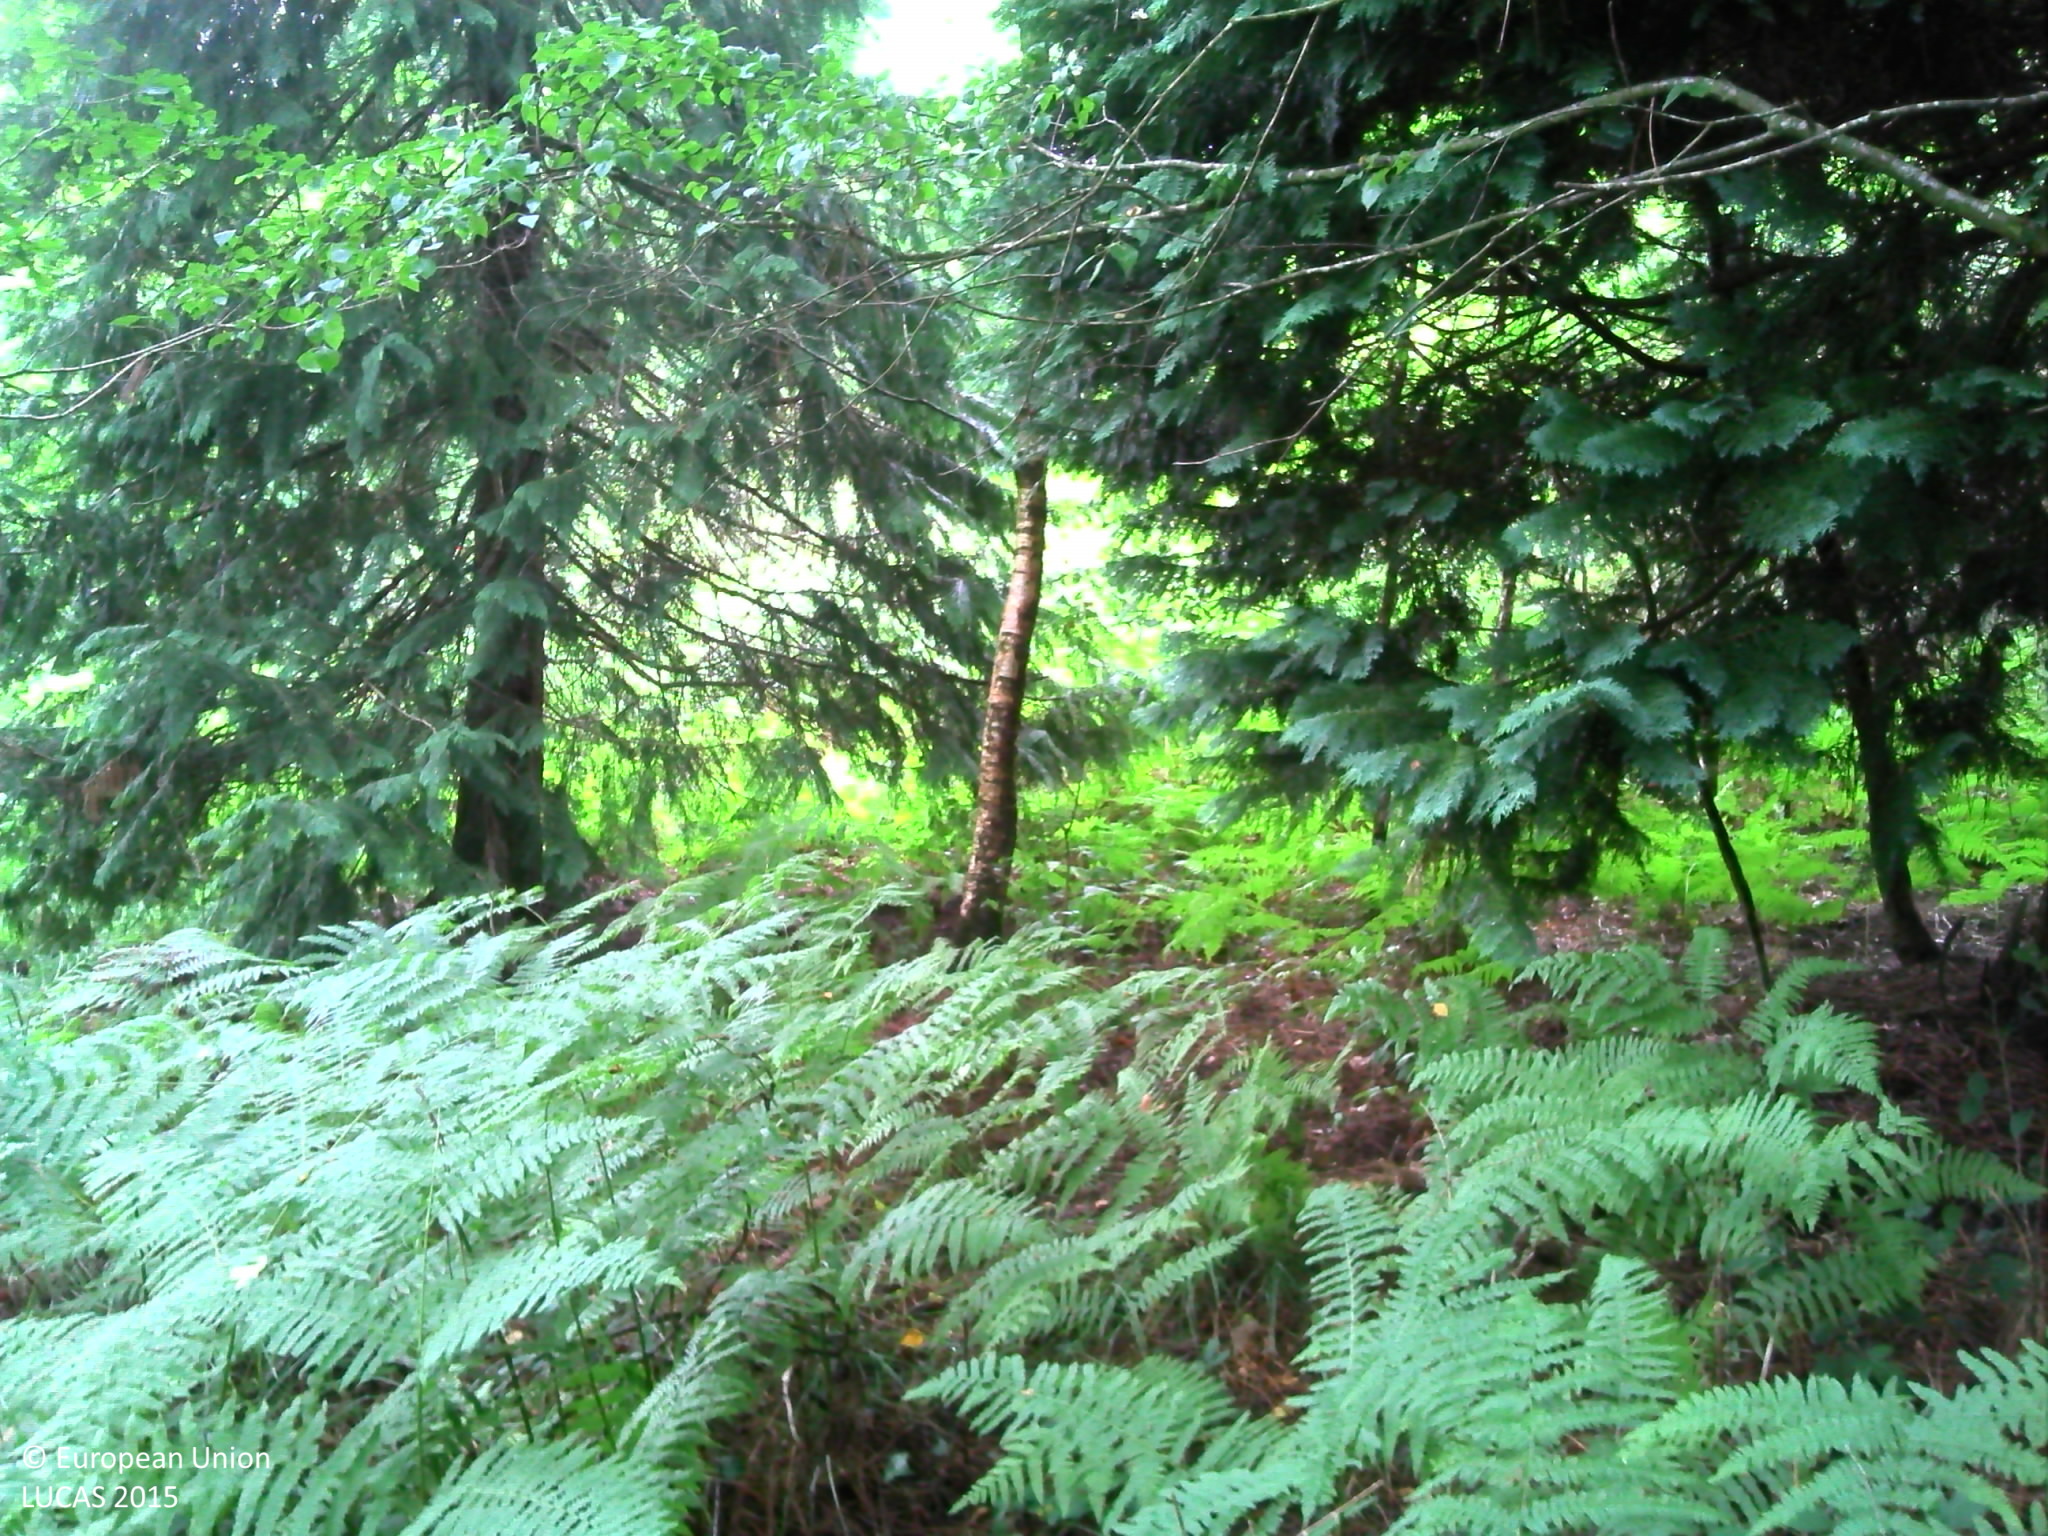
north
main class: Woodland
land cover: Other mixed woodland
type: exotic forest
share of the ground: > 75 %
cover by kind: broadleaved forest trees 40 %, coniferous forest trees 30 %, shrubs 10 %, herbaceous plants 10 %, consolidated bare surface 10 %
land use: Forestry
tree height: > 5 m
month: July
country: FR
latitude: 47.8405
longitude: -2.9330
